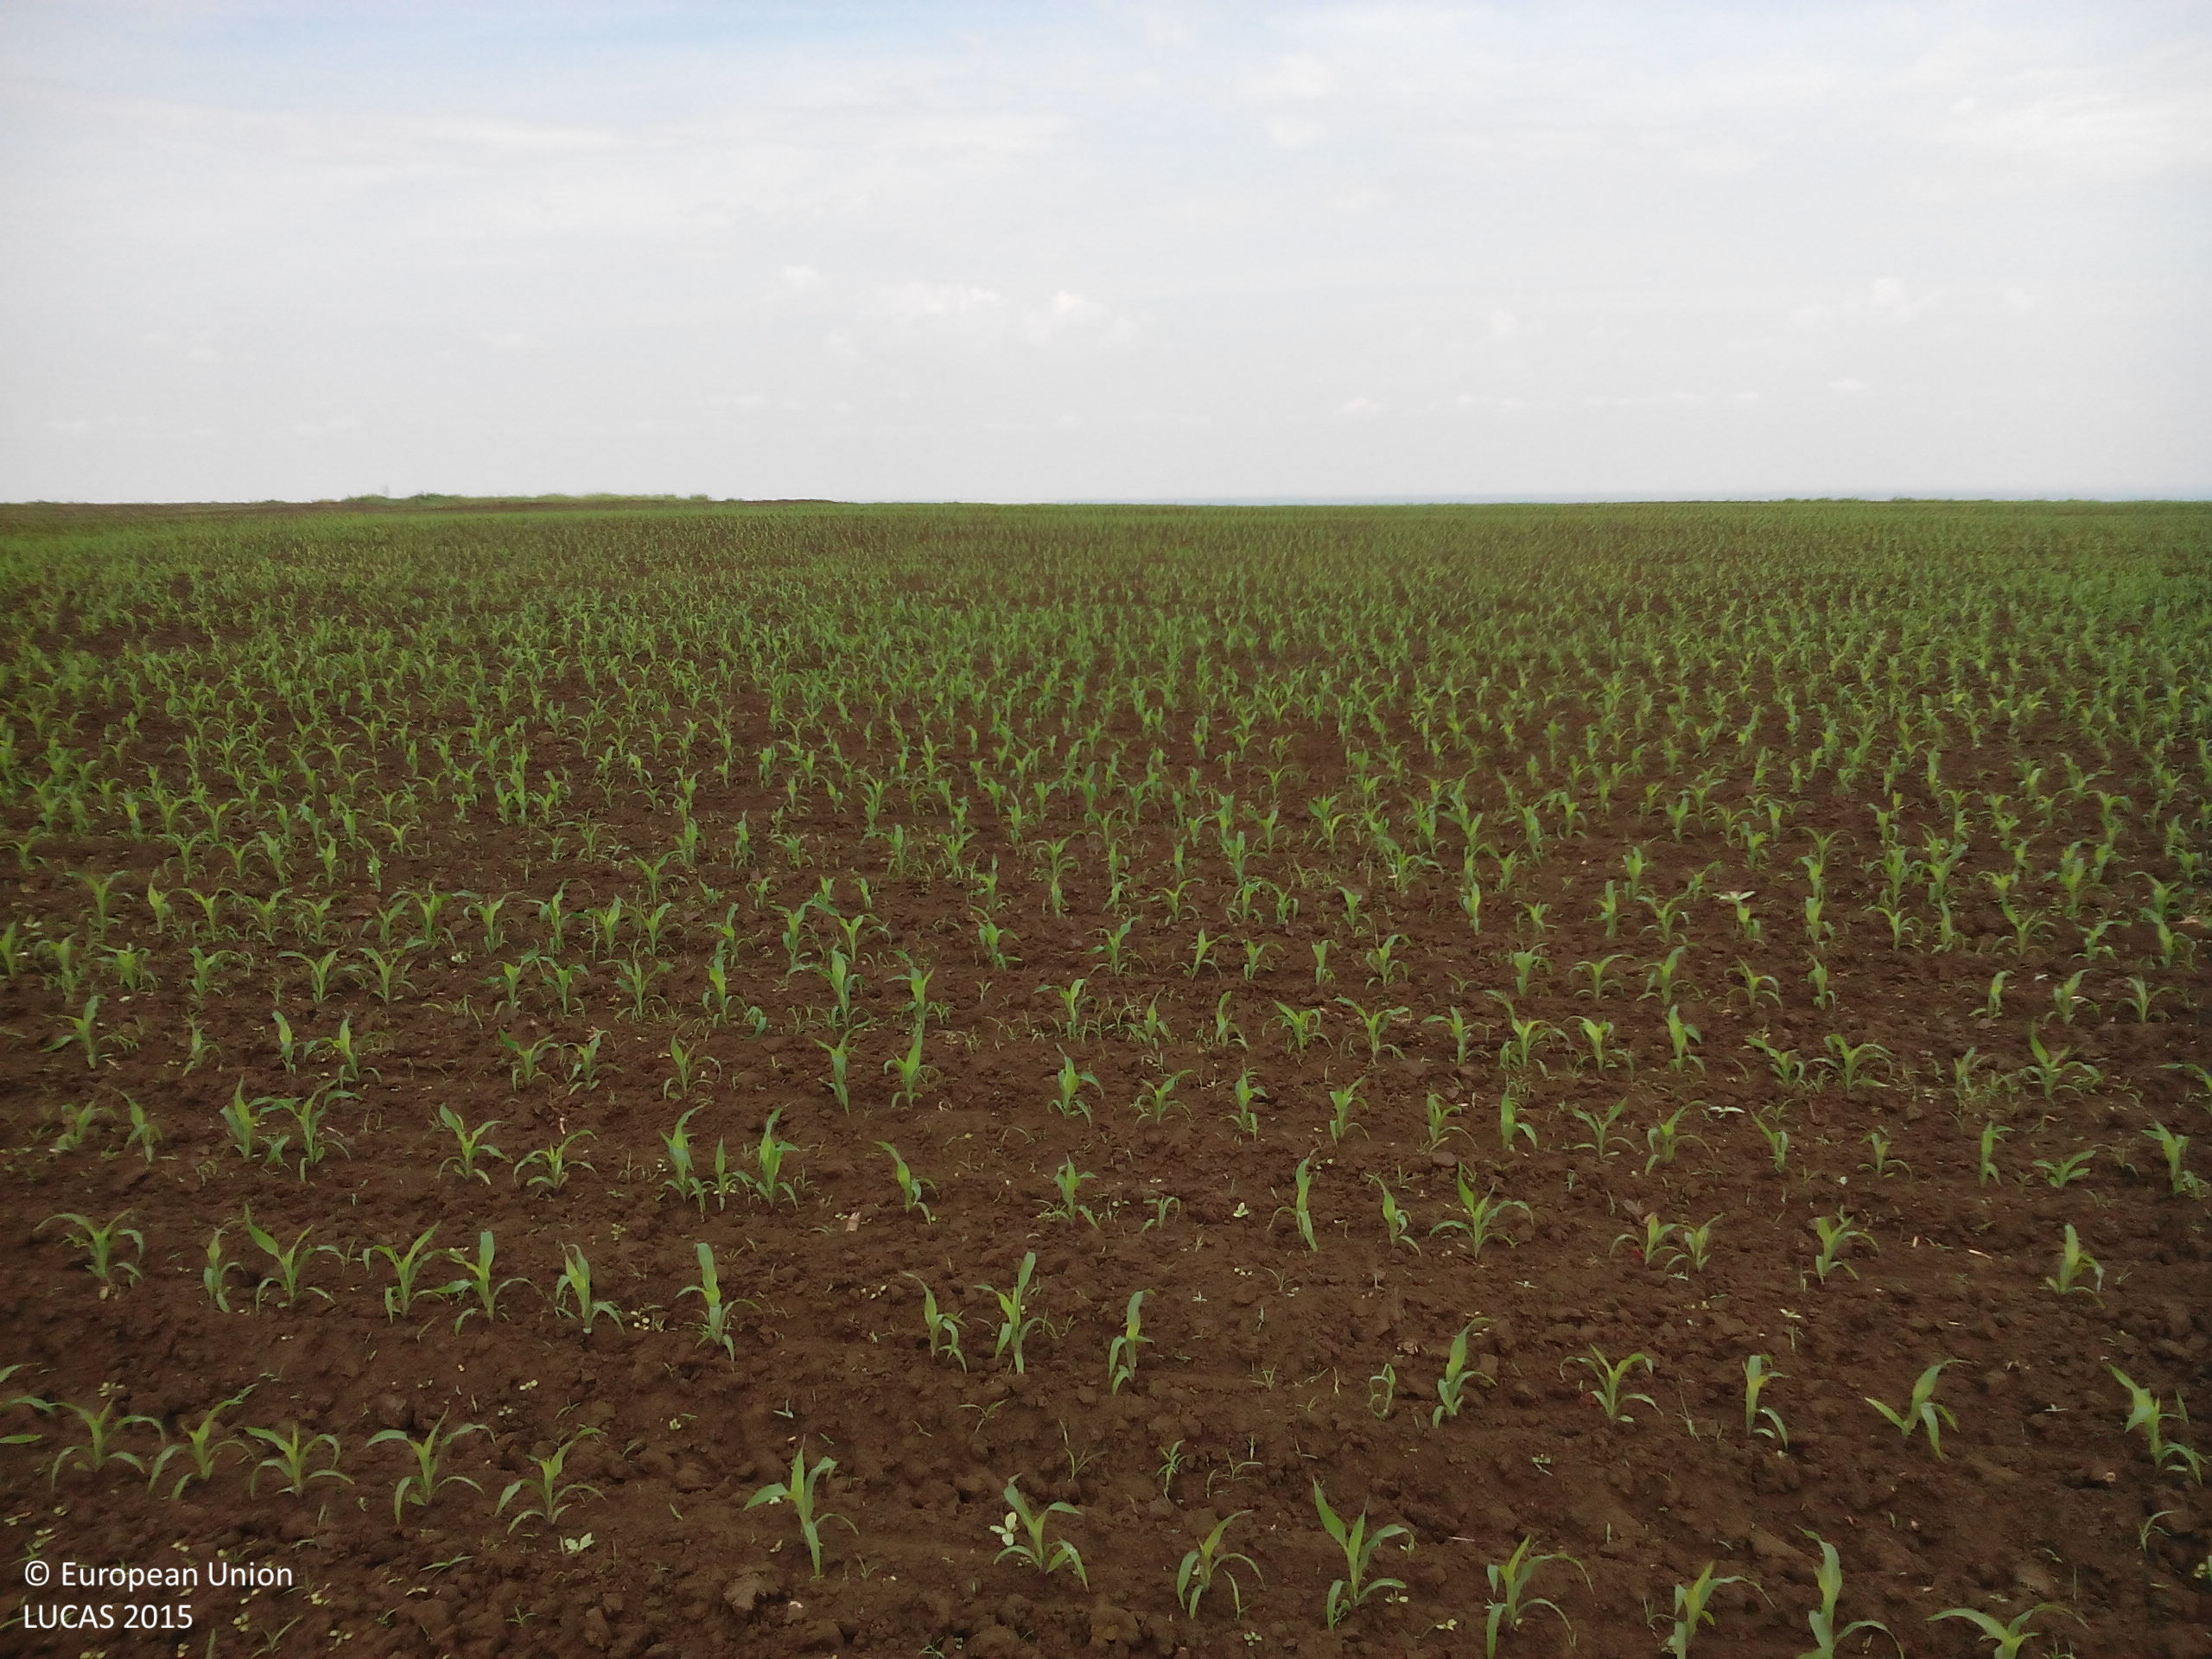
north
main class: Cropland
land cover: Maize
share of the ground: 10 - 25 %
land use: Agriculture (excluding fallow land and kitchen gardens)
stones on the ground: < 10 %
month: May
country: BG
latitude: 43.6141
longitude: 23.7414
